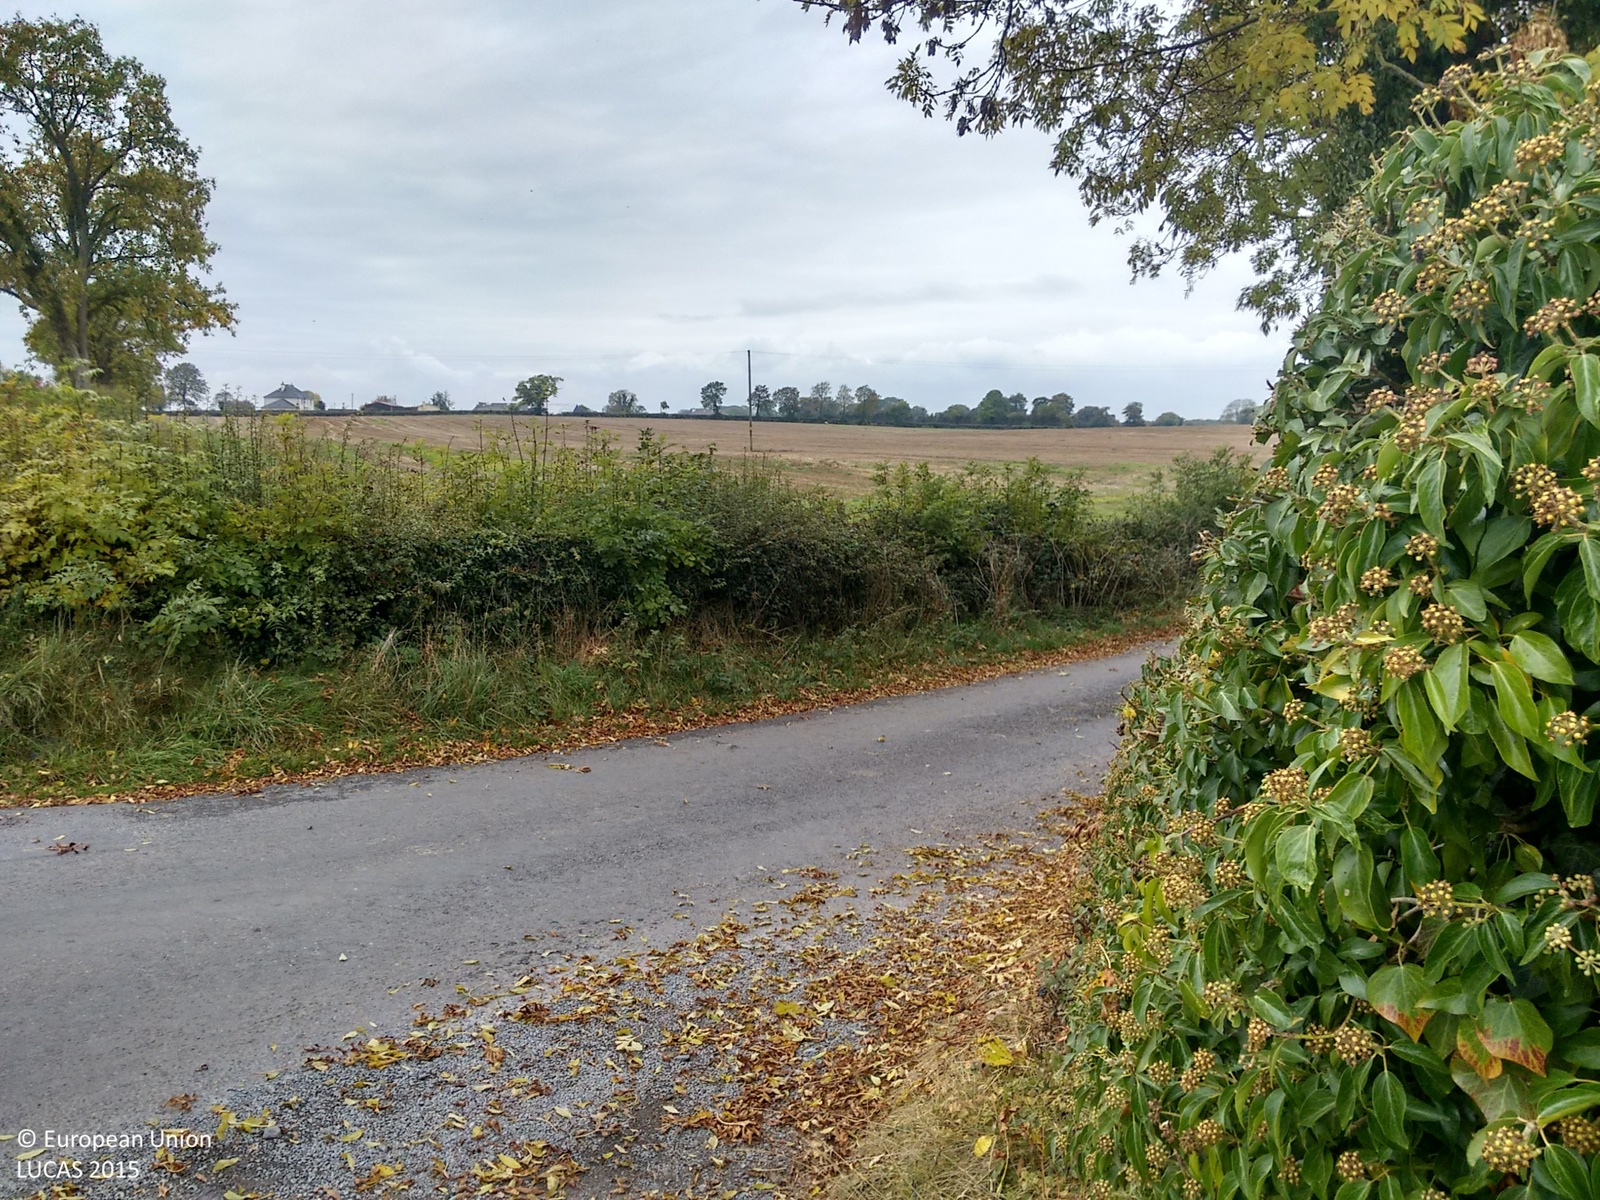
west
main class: Grassland
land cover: Grassland without tree/shrub cover
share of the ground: > 75 %
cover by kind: herbaceous plants 95 %
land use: Agriculture (excluding fallow land and kitchen gardens)
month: October
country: IE
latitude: 52.8125
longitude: -7.5025
